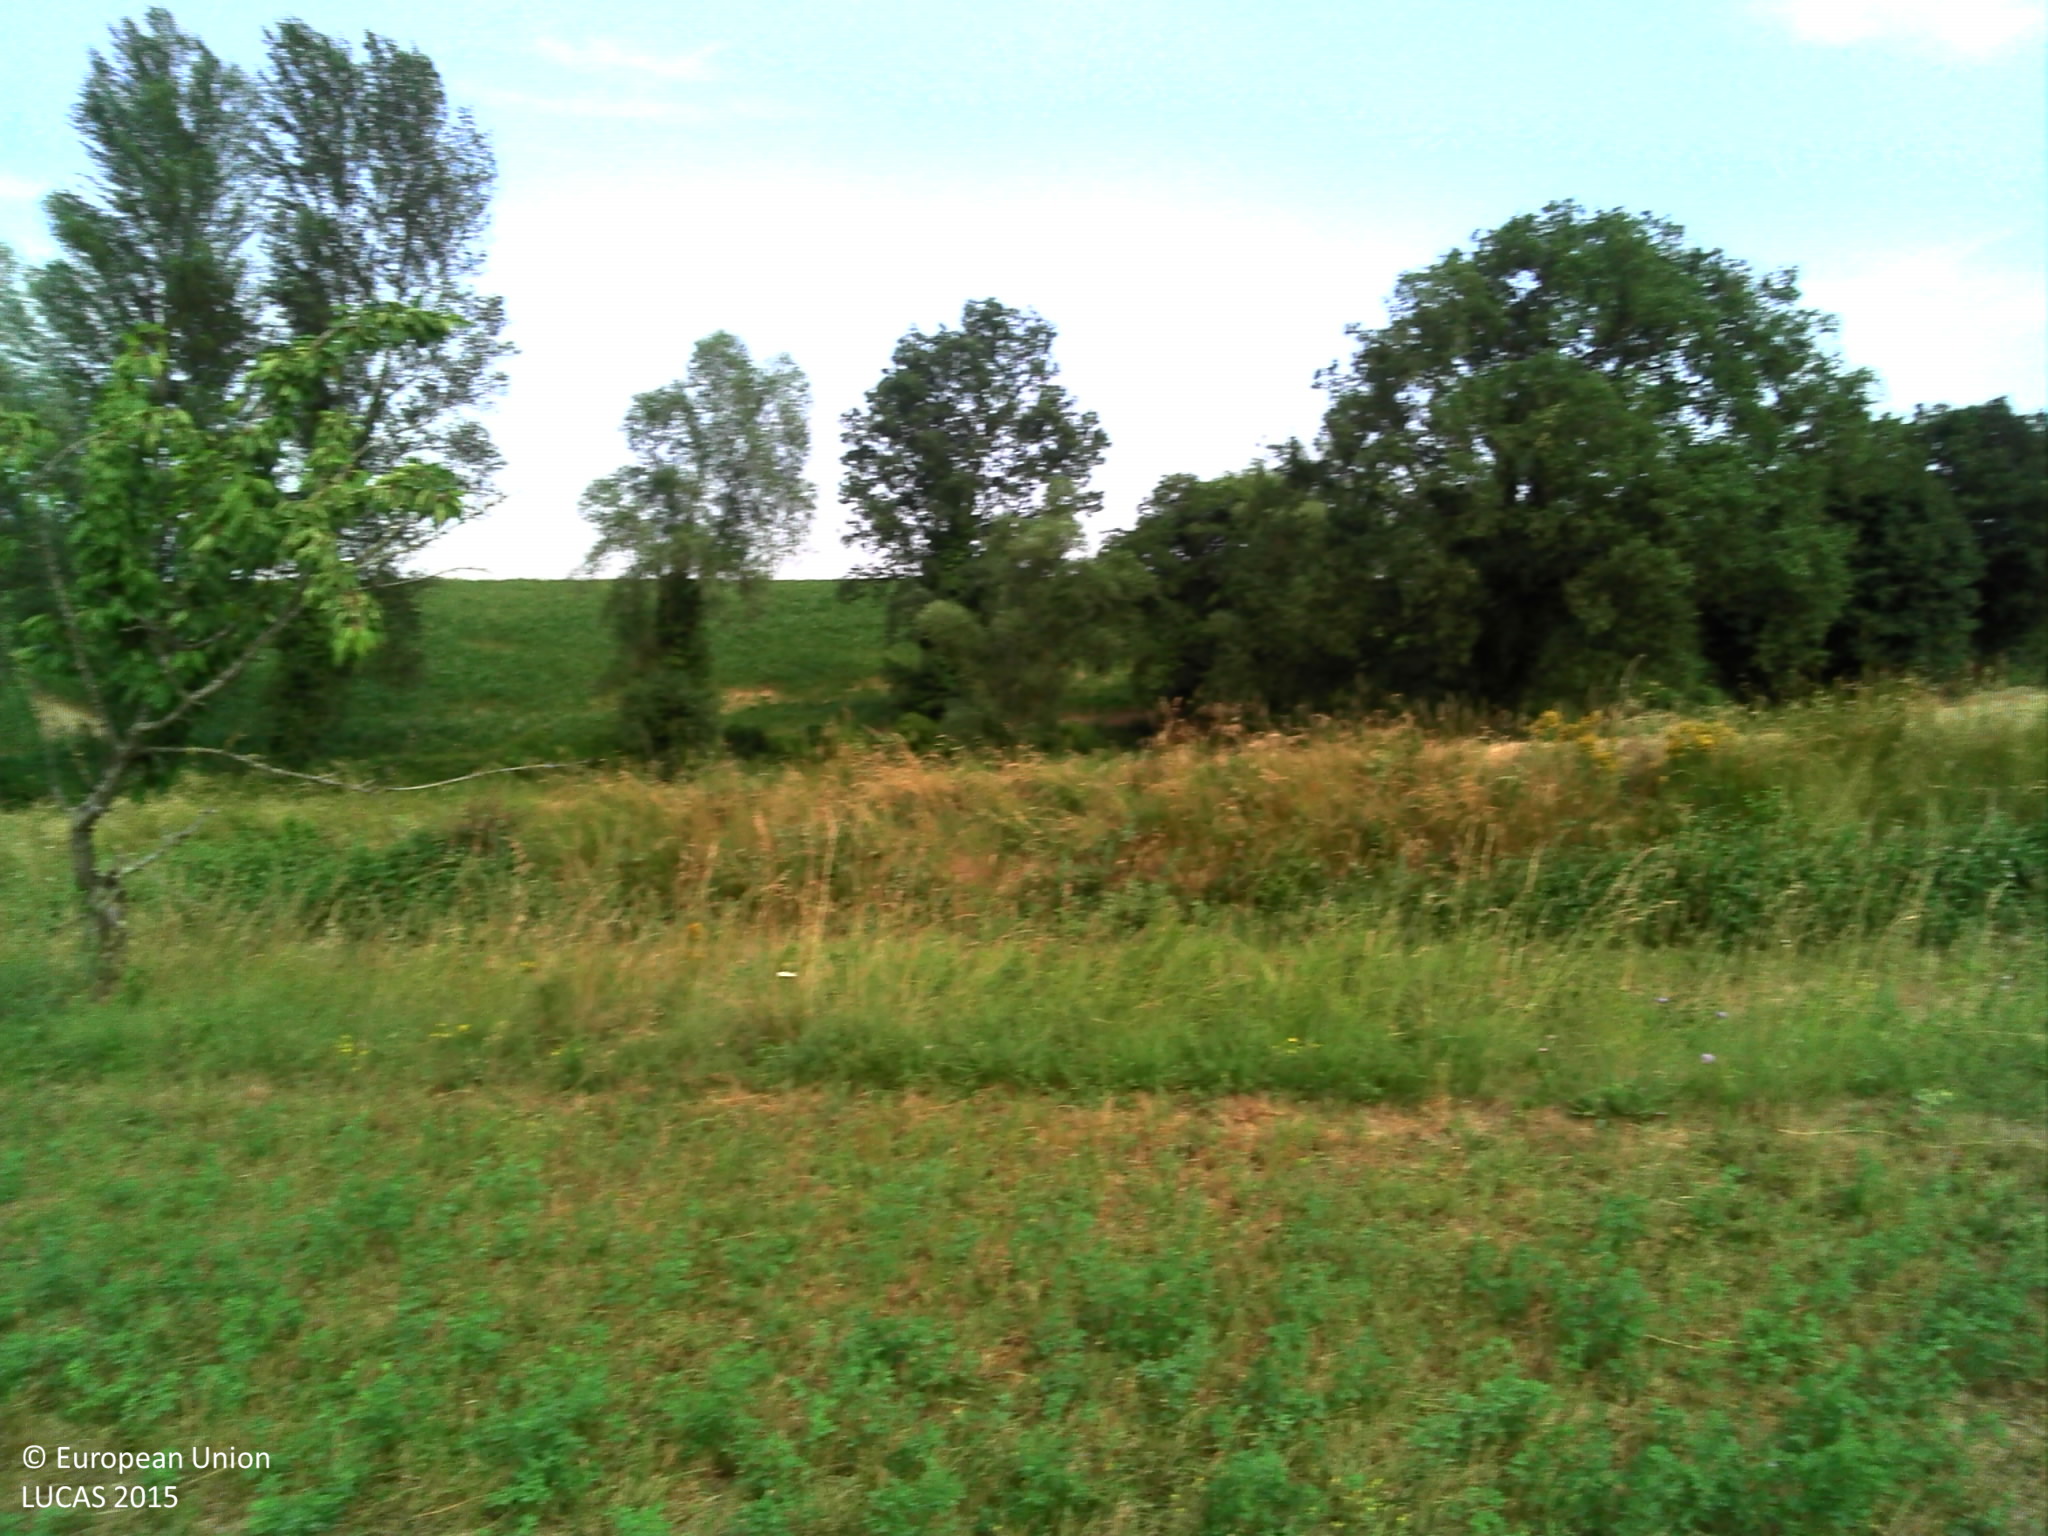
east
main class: Cropland
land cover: Lucerne
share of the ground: > 75 %
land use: Agriculture (excluding fallow land and kitchen gardens)
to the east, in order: Lucerne; Lines of trees; Ditches and canals; Tracks; Ditches and canals; Grass margins; Durum wheat; Spontaneously vegetated surfaces; Ditches and canals; Broadleaved woodland; Tracks; Maize
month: July
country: FR
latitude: 43.6134
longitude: 0.9922
